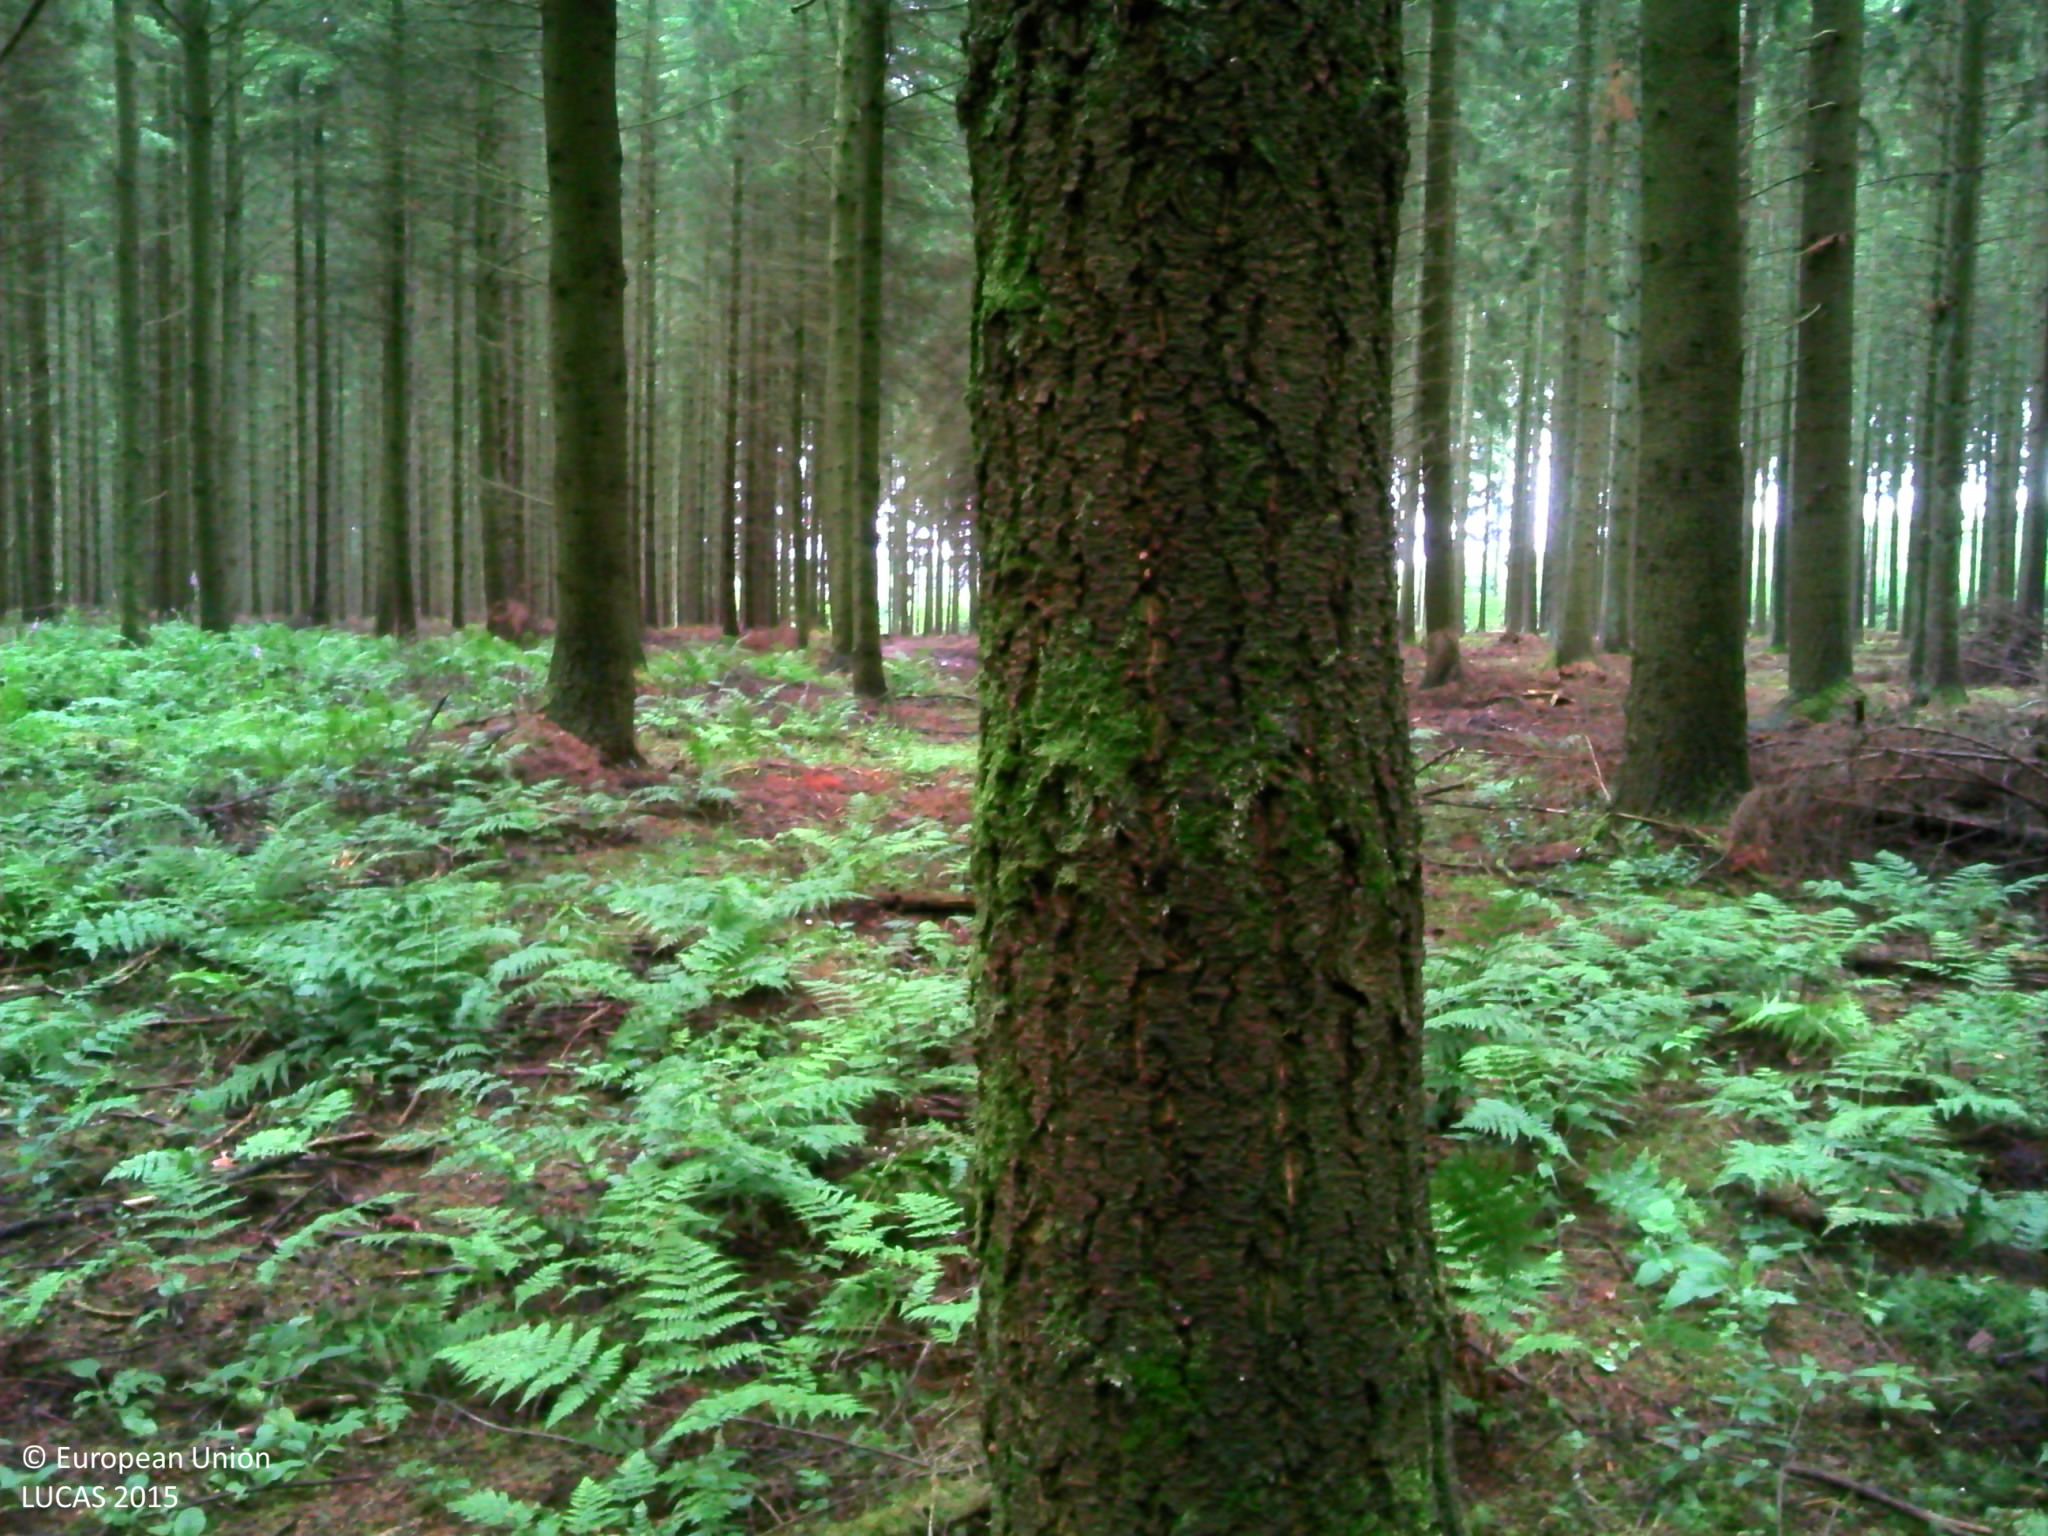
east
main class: Woodland
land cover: Other coniferous woodland
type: exotic forest
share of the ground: > 75 %
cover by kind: coniferous forest trees 95 %, herbaceous plants 5 %
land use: Forestry
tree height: > 5 m
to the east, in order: Other coniferous woodland; Spruce dominated coniferous woodland; Tracks; Spruce dominated coniferous woodland
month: July
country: BE
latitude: 50.1235
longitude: 5.7606
